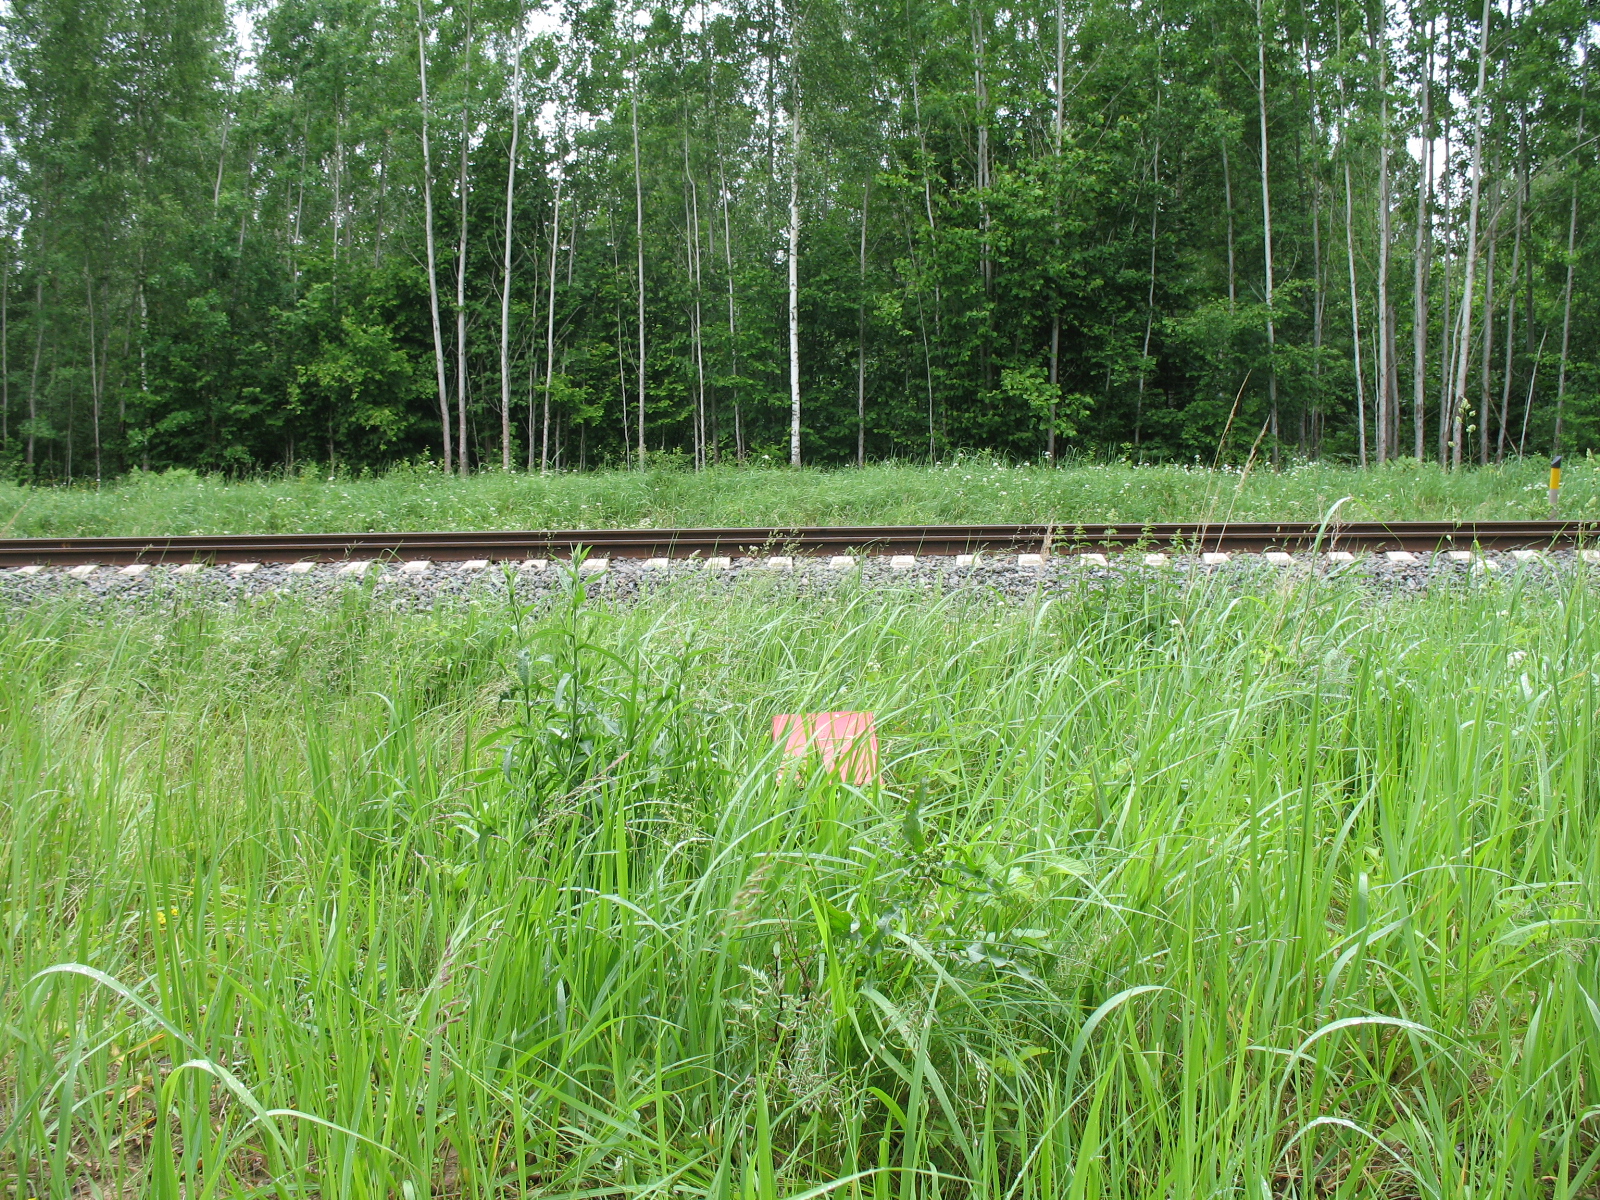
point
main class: Grassland
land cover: Spontaneously vegetated surfaces
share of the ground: 50 - 75 %
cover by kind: herbaceous plants 60 %, unconsolidated bare surface 40 %
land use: Railway transport
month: June
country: LV
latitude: 56.3835
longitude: 23.6670
